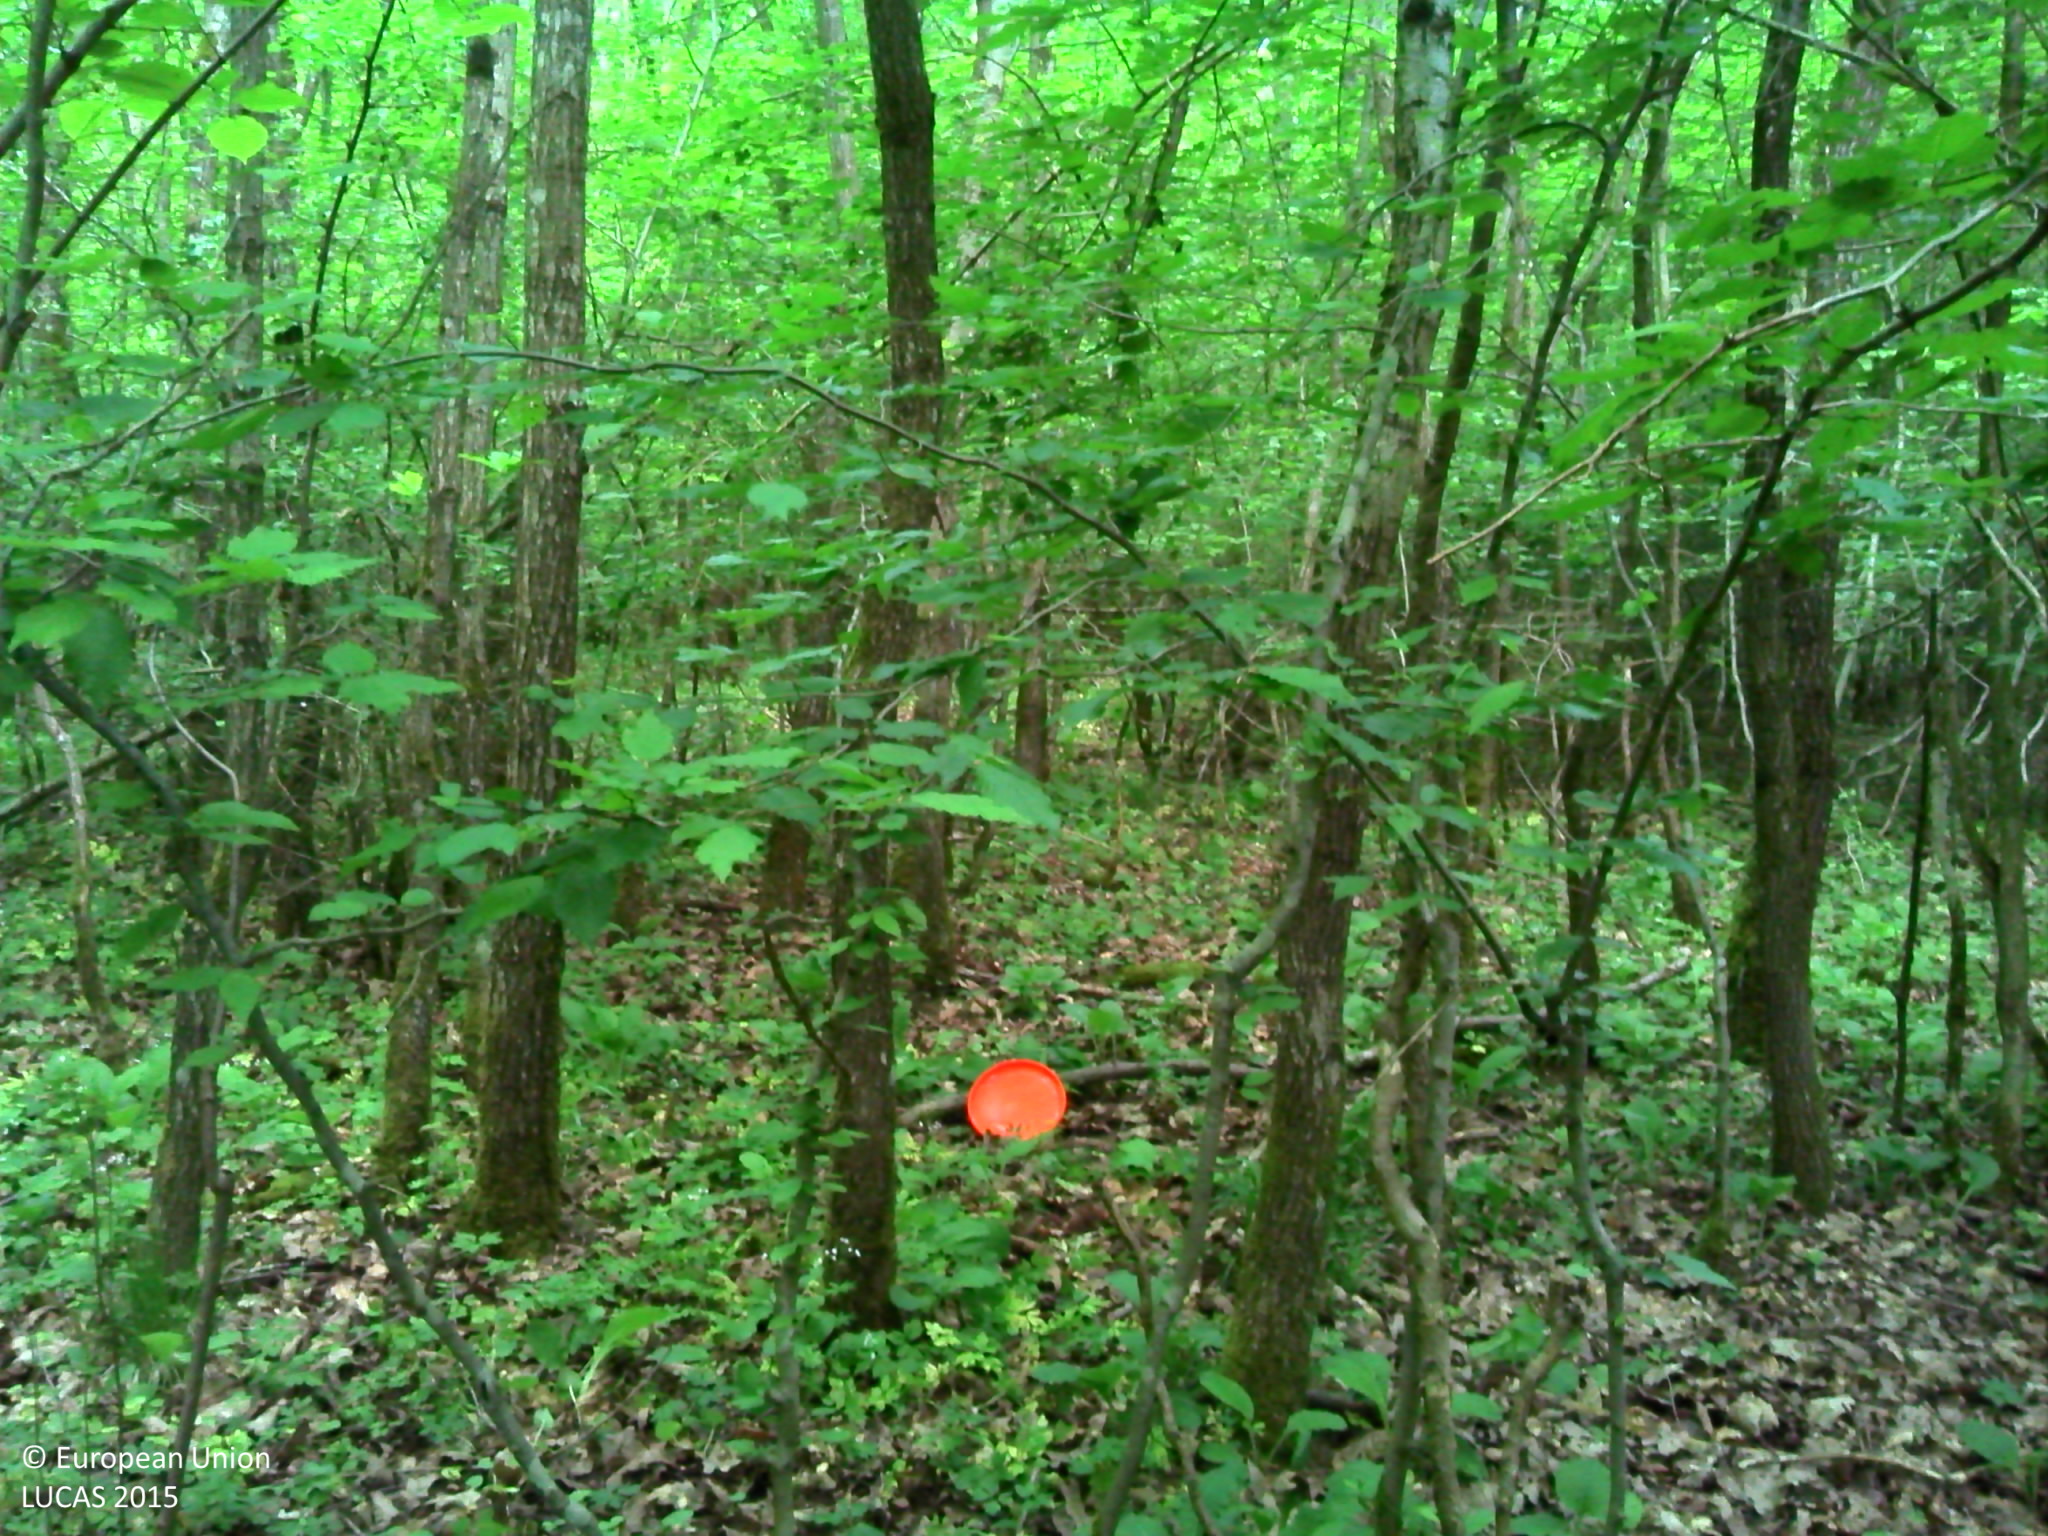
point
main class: Woodland
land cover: Broadleaved woodland
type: mesophytic deciduous forest
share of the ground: > 75 %
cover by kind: broadleaved forest trees 90 %, herbaceous plants 5 %, lichens and mosses 5 %
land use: Forestry
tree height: > 5 m
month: May
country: LU
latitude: 49.6769
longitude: 6.3827
